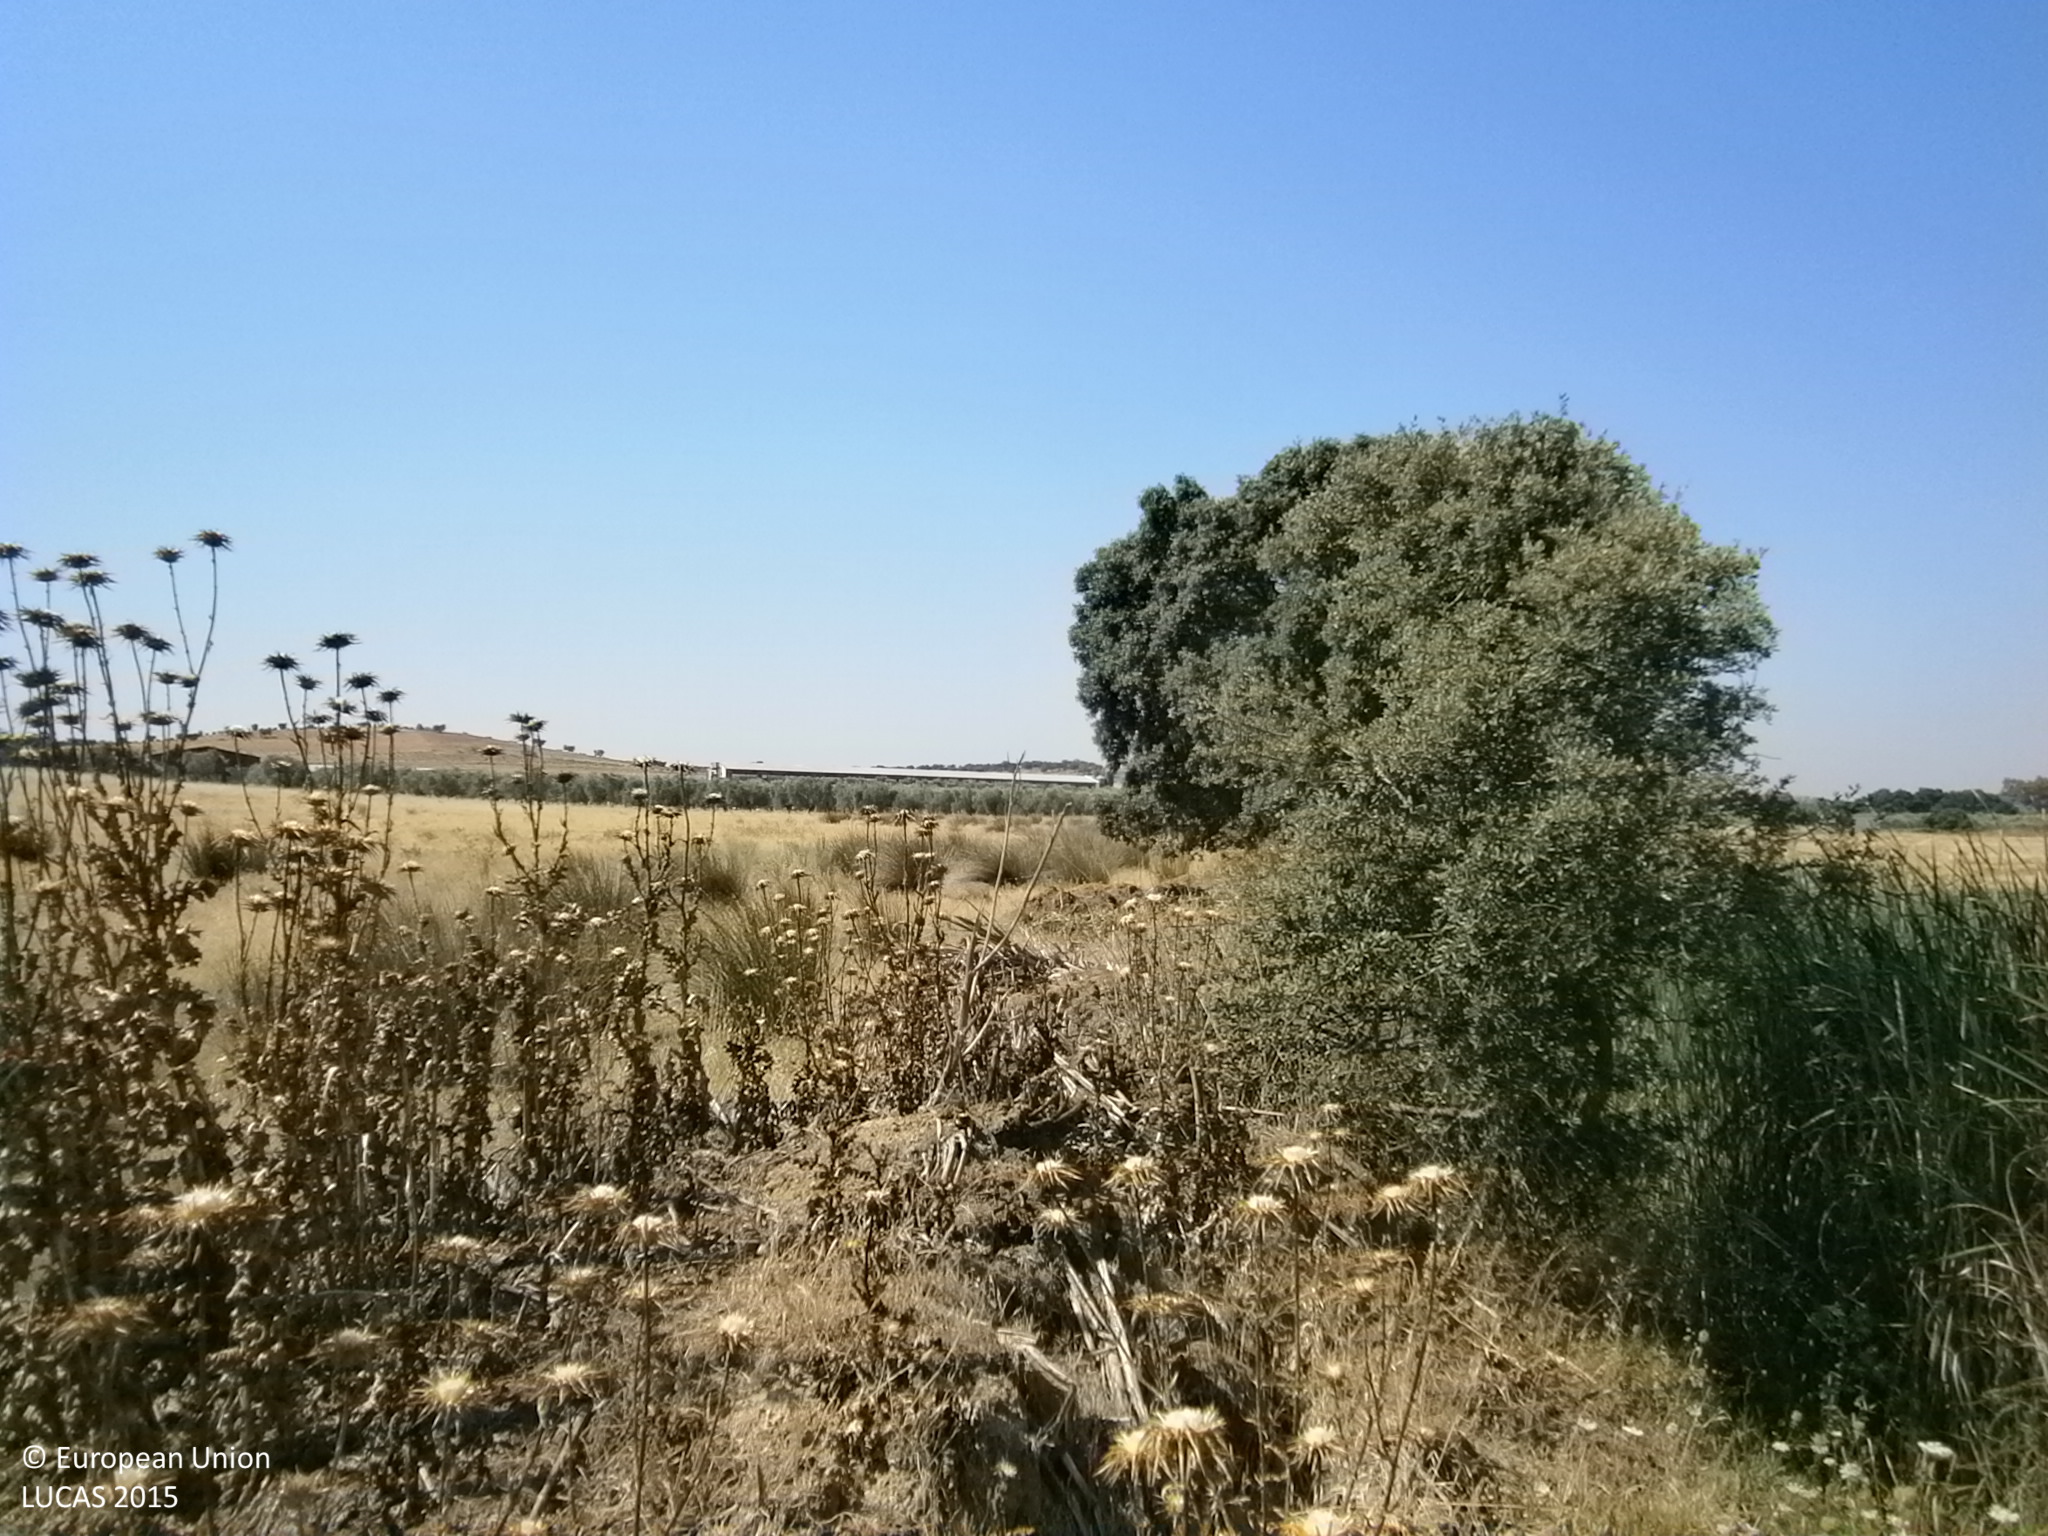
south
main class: Cropland
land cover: Tomatoes
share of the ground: > 75 %
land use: Agriculture (excluding fallow land and kitchen gardens)
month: June
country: ES
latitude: 38.8507
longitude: -6.7610
